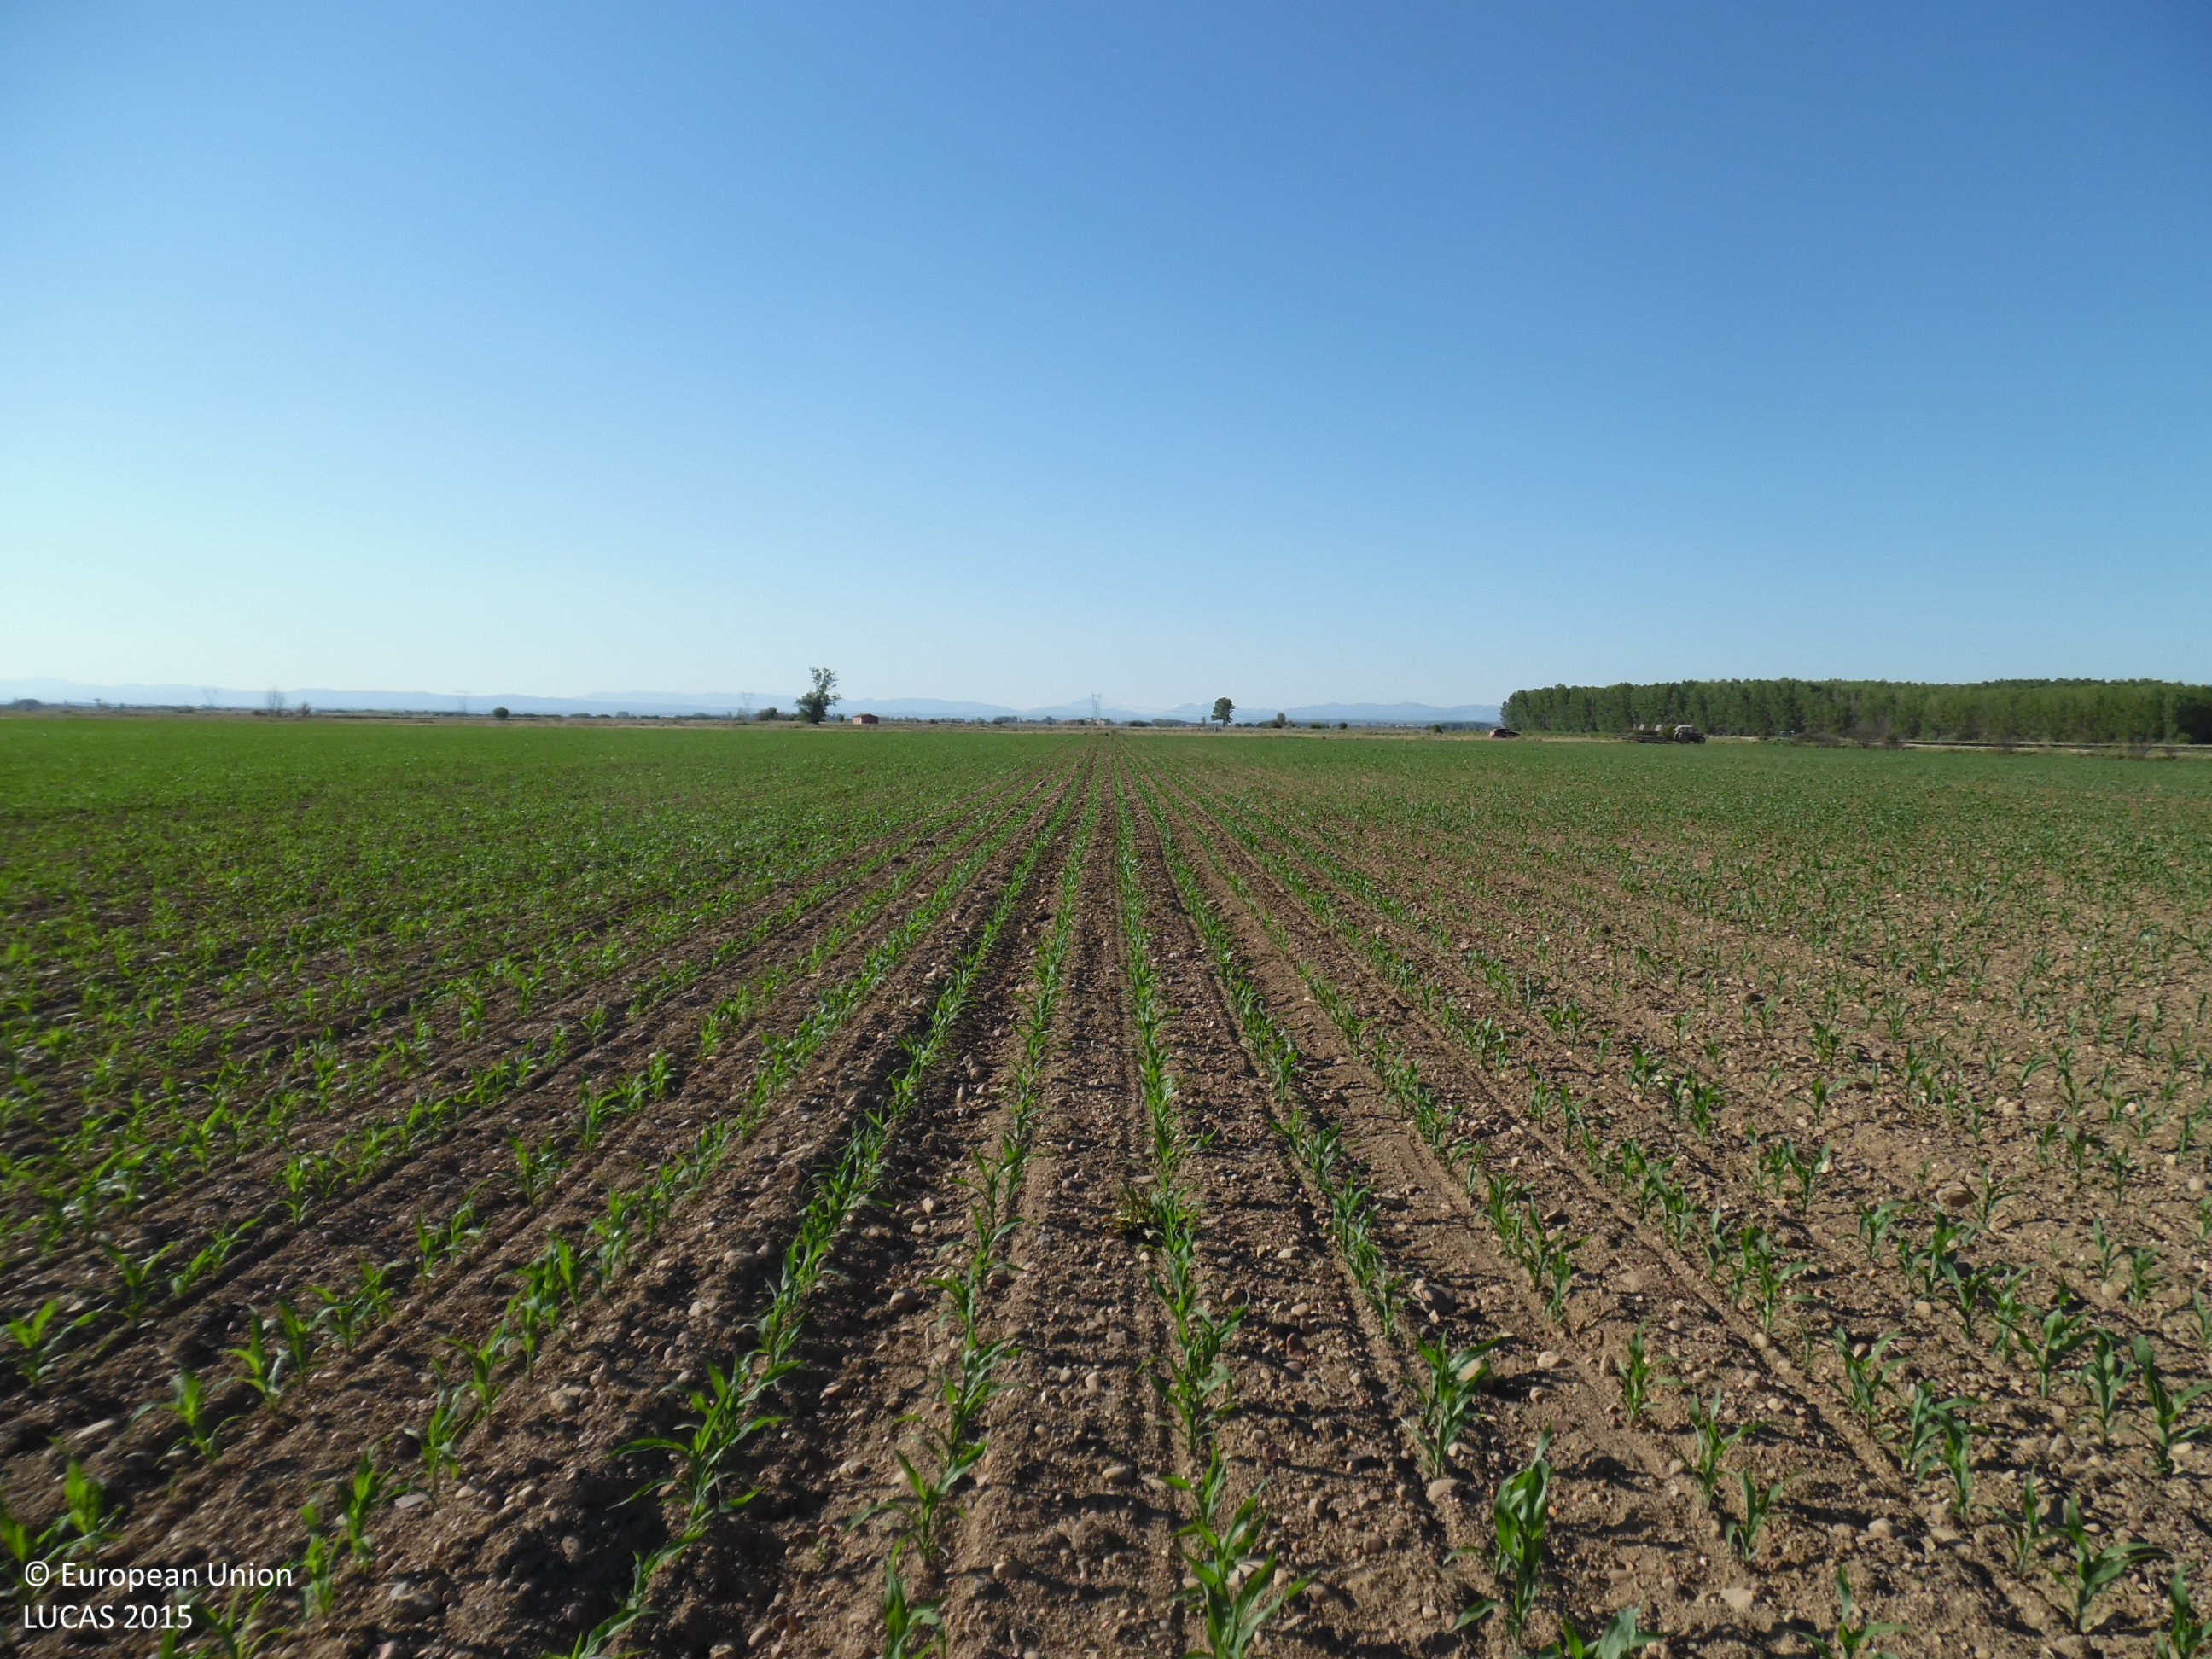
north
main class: Cropland
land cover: Maize
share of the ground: 25 - 50 %
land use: Agriculture (excluding fallow land and kitchen gardens)
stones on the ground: 10 - 25 %
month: June
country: ES
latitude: 42.4734
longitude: -5.7786
